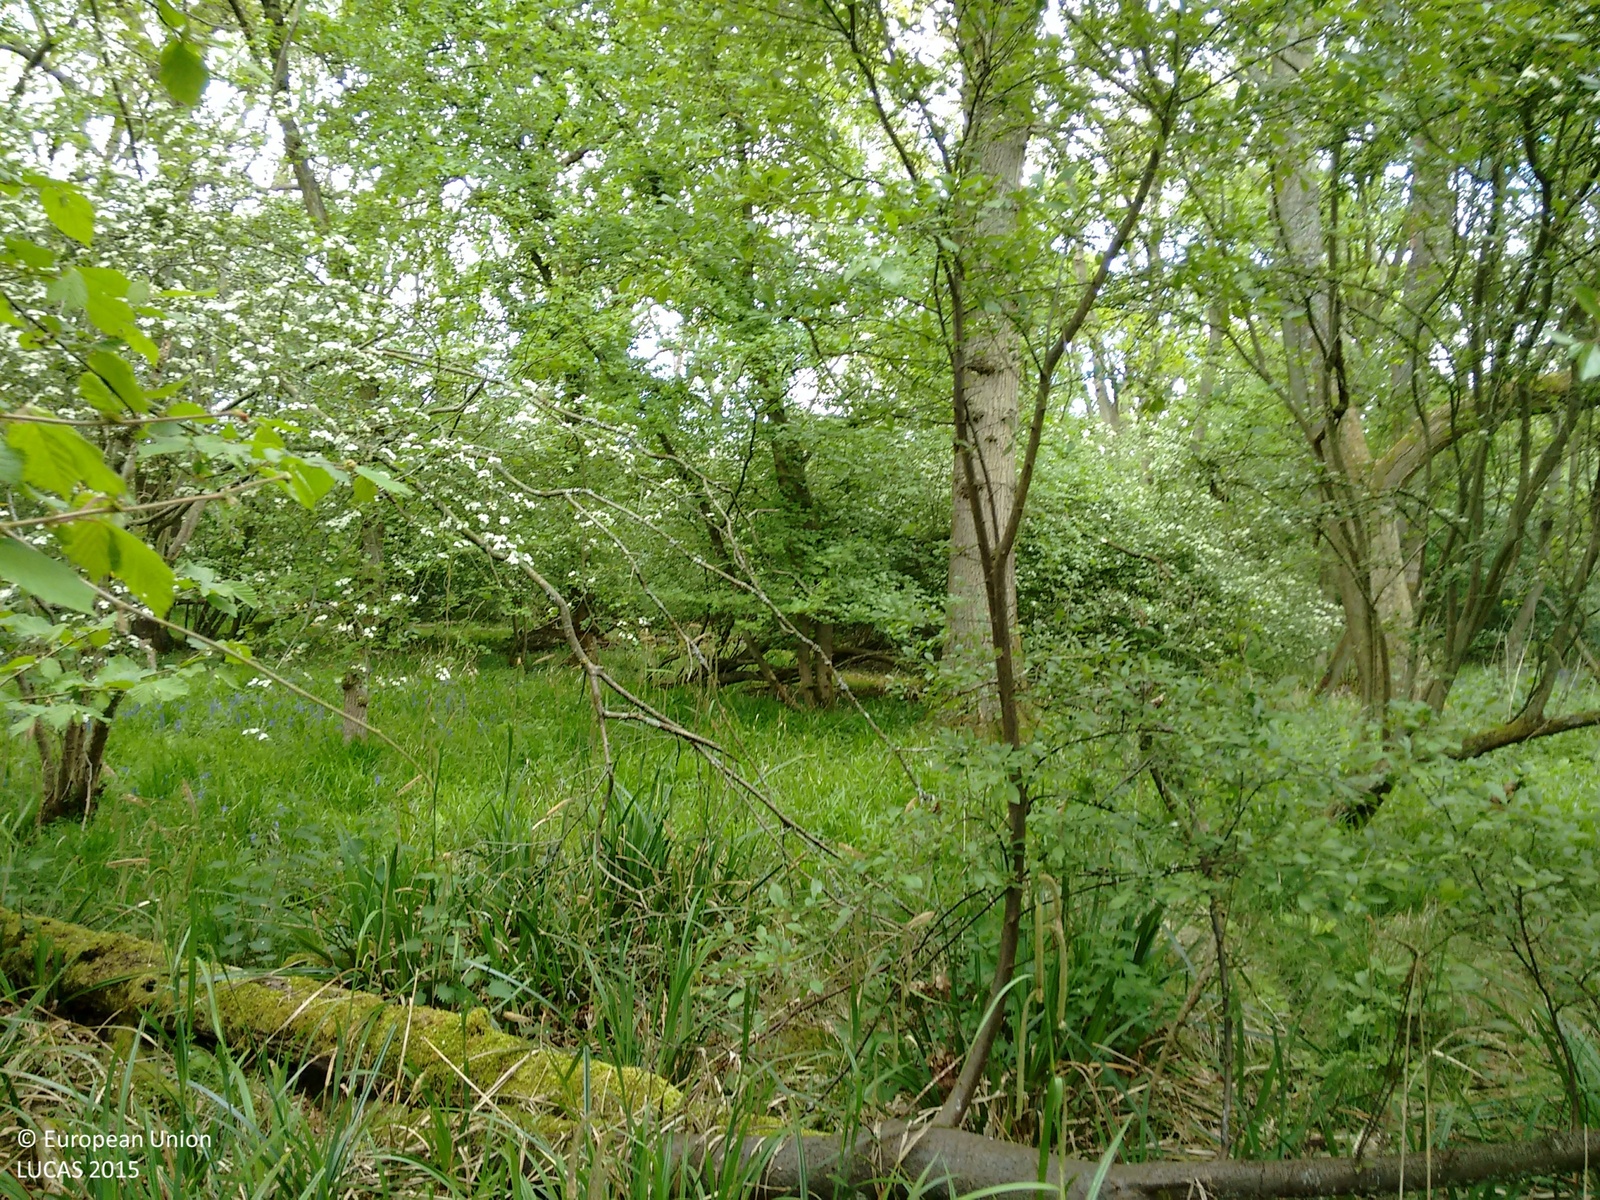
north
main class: Woodland
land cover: Broadleaved woodland
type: mesophytic deciduous forest
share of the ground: > 75 %
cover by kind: broadleaved forest trees 100 %
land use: Community services
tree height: > 5 m
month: May
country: GB
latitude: 52.0660
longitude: -0.5859
